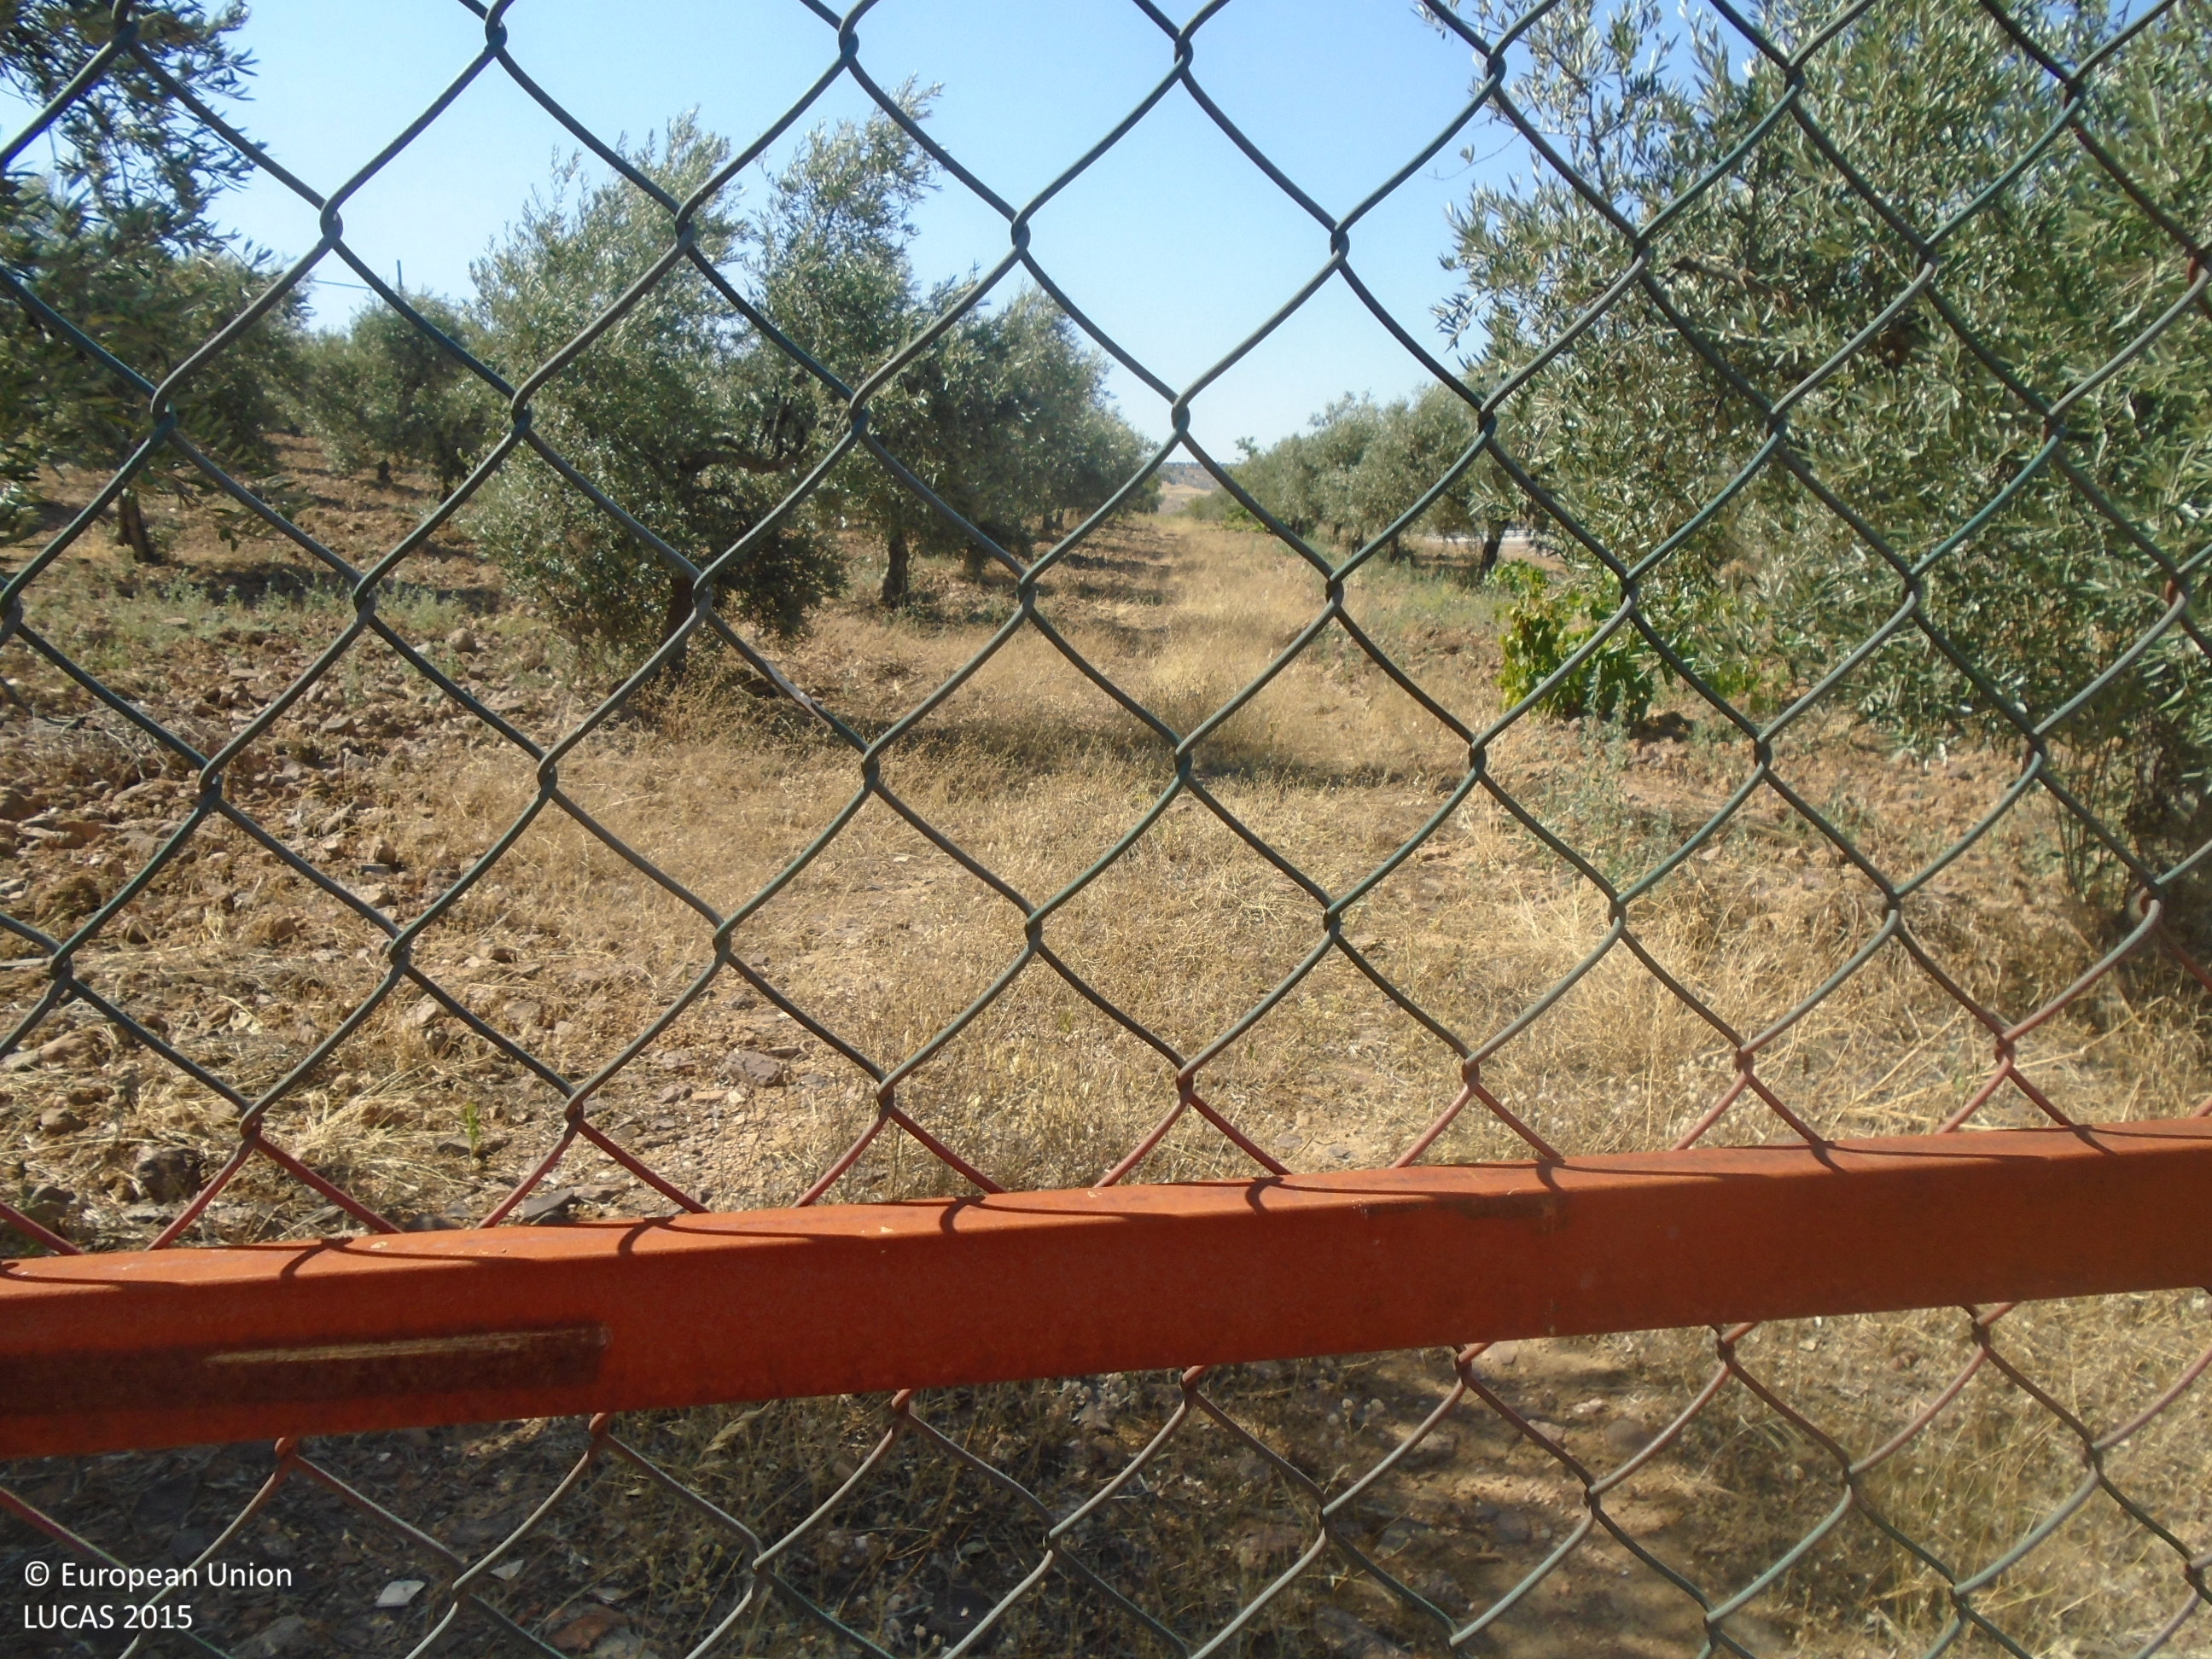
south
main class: Cropland
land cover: Olive groves
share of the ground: 10 - 25 %
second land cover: Spontaneously vegetated surfaces
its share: > 75 %
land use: Agriculture (excluding fallow land and kitchen gardens)
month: July
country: ES
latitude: 39.6401
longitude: -4.9956
